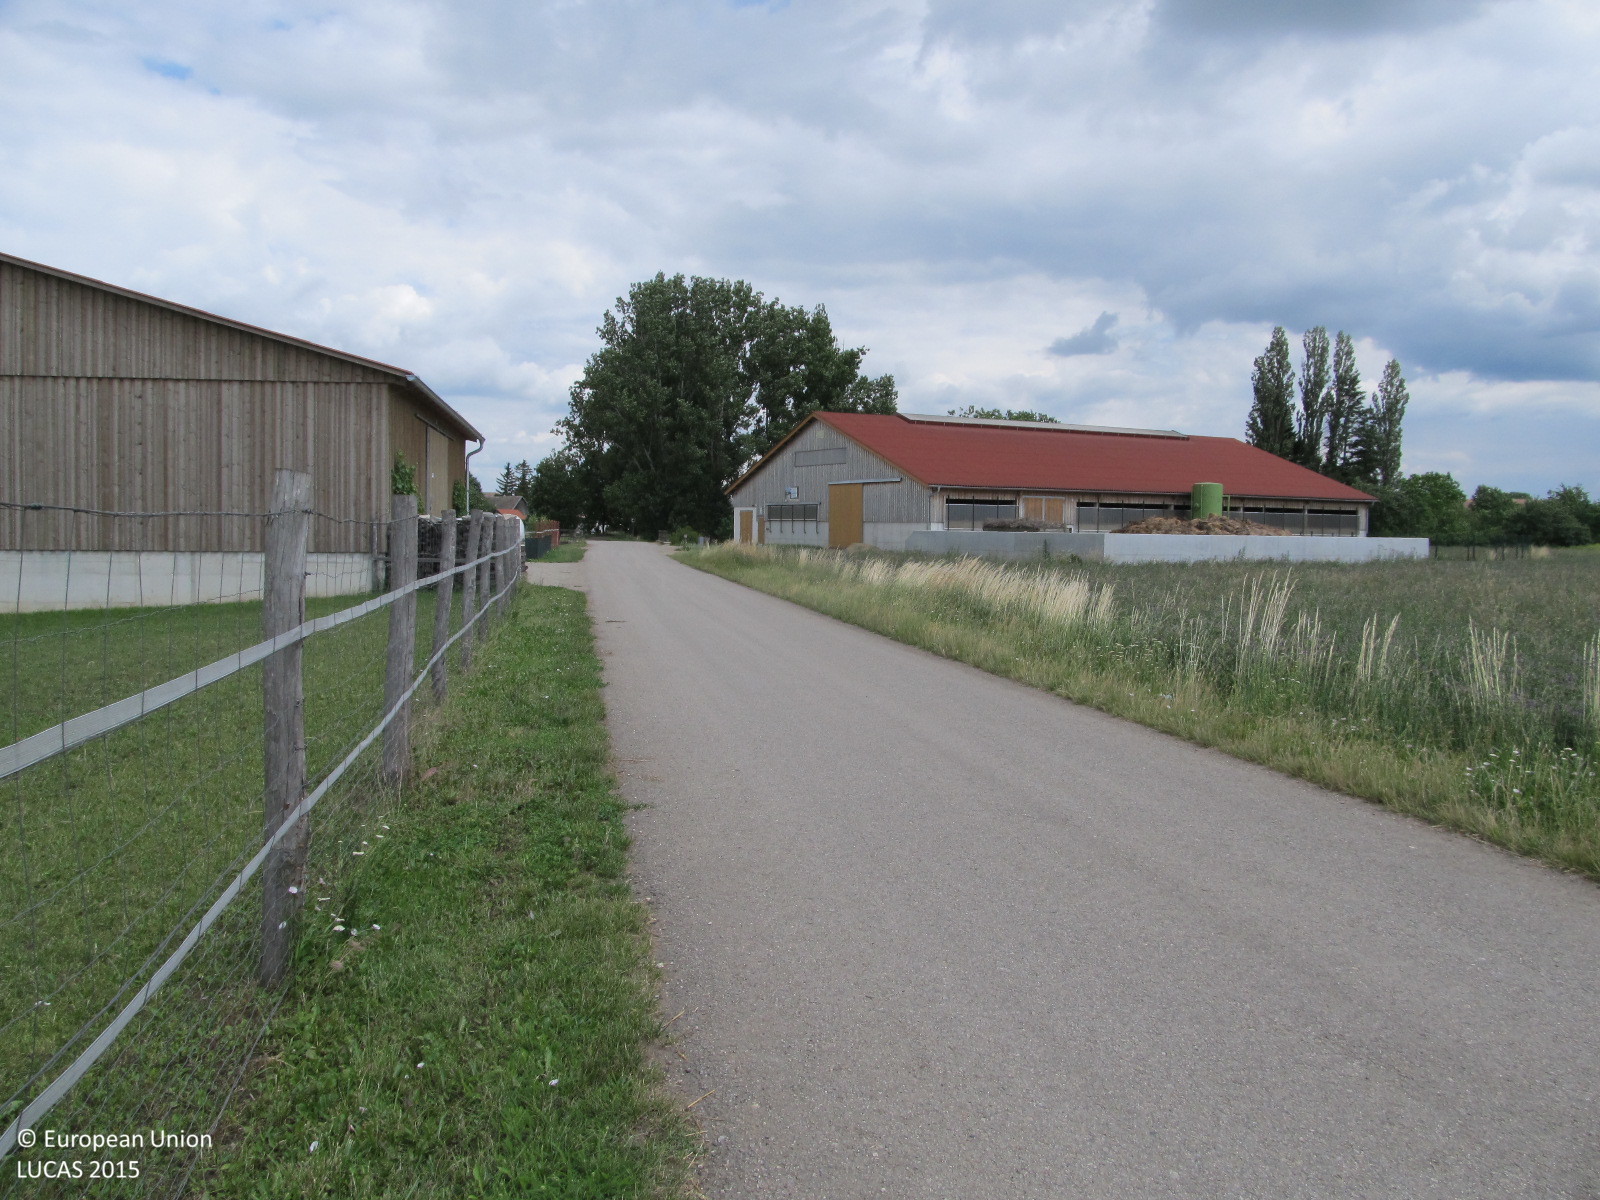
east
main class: Grassland
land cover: Grassland without tree/shrub cover
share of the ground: > 75 %
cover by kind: herbaceous plants 100 %
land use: Agriculture (excluding fallow land and kitchen gardens)
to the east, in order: Grassland without tree/shrub cover; Fences; Grassland without tree/shrub cover; Artificial constructions in urban areas; Fences; Grassland without tree/shrub cover; Ditches and canals; Grassland without tree/shrub cover; Ditches and canals; Grassland without tree/shrub cover; Tracks; Sugar beet; Grass margins; Tracks; Barley; Tracks
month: June
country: AT
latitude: 48.6322
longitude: 16.0972
